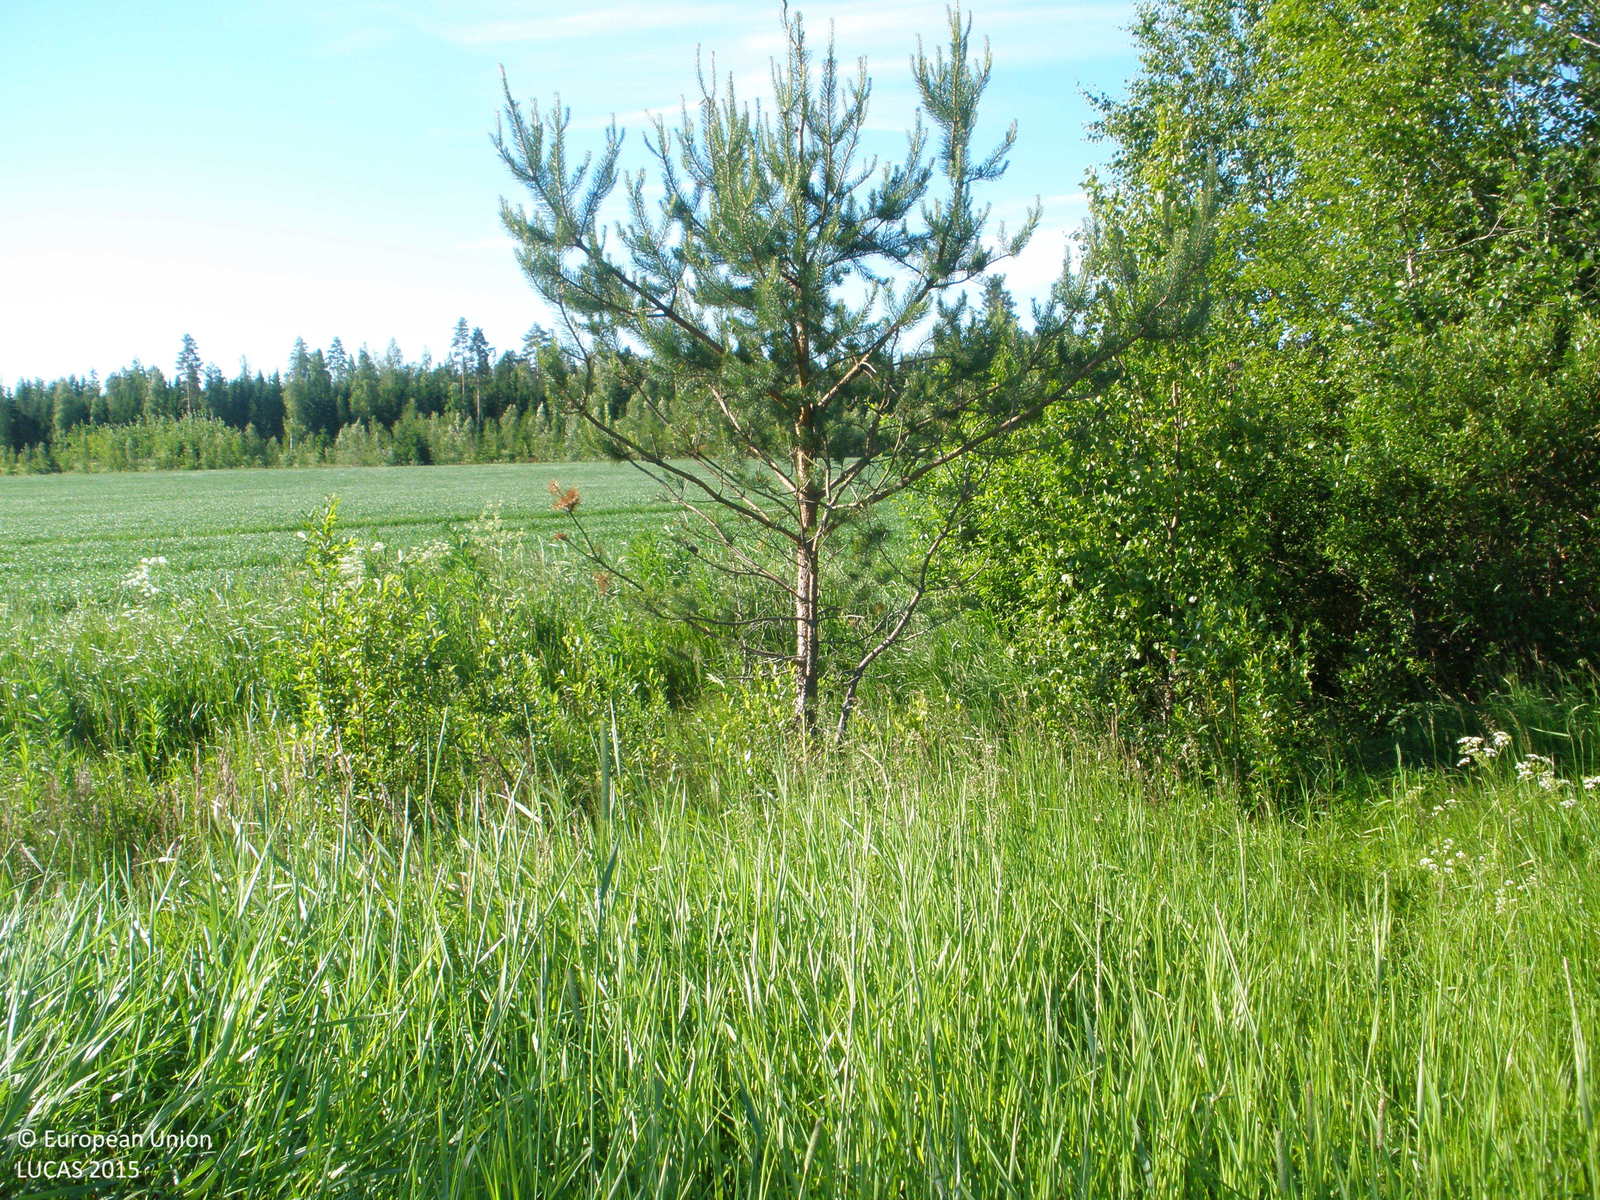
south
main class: Cropland
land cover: Mixed cereals for fodder
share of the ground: 25 - 50 %
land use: Agriculture (excluding fallow land and kitchen gardens)
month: July
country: FI
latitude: 61.2302
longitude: 23.8903
